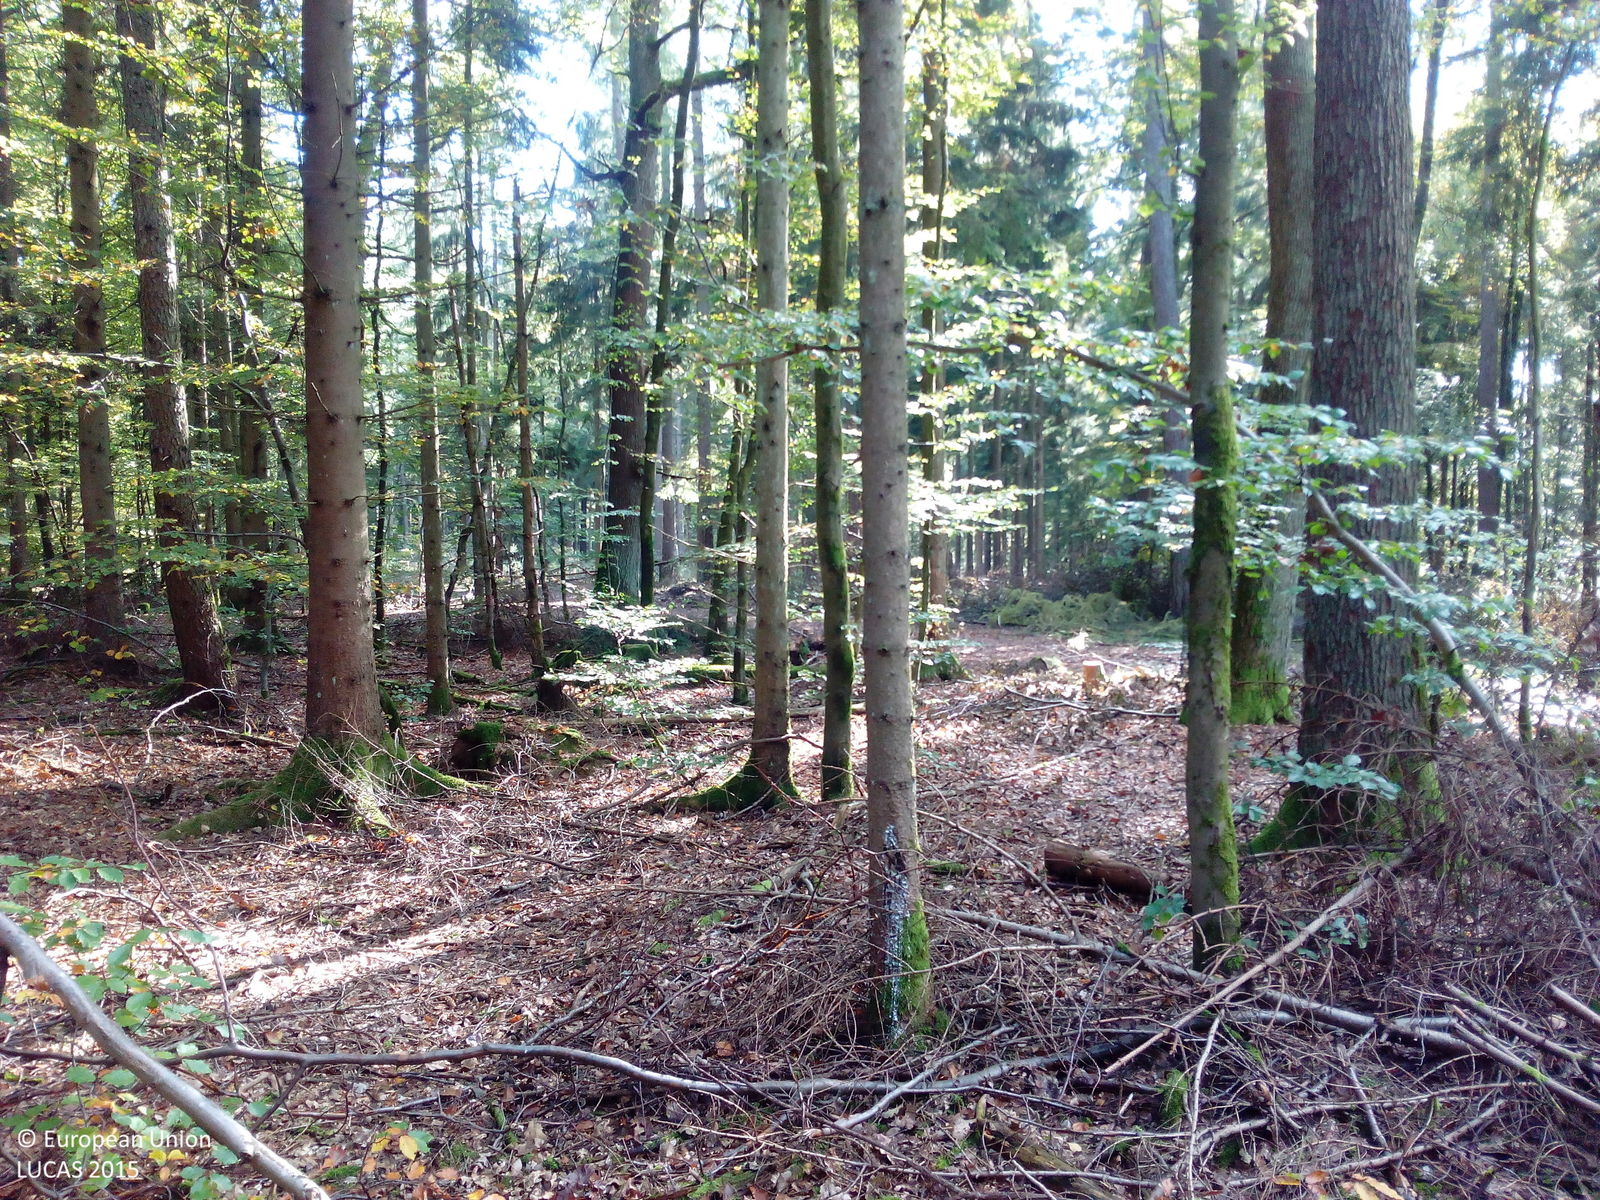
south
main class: Woodland
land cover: Spruce dominated mixed woodland
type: hemiboreal forest and nemoral coniferous forest and mixed broadleaved-coniferous forest
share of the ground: > 75 %
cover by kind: coniferous forest trees 55 %, broadleaved forest trees 20 %, herbaceous plants 15 %, shrubs 5 %, lichens and mosses 5 %
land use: Forestry
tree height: > 5 m
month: October
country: DE
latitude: 50.0927
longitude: 9.3991
